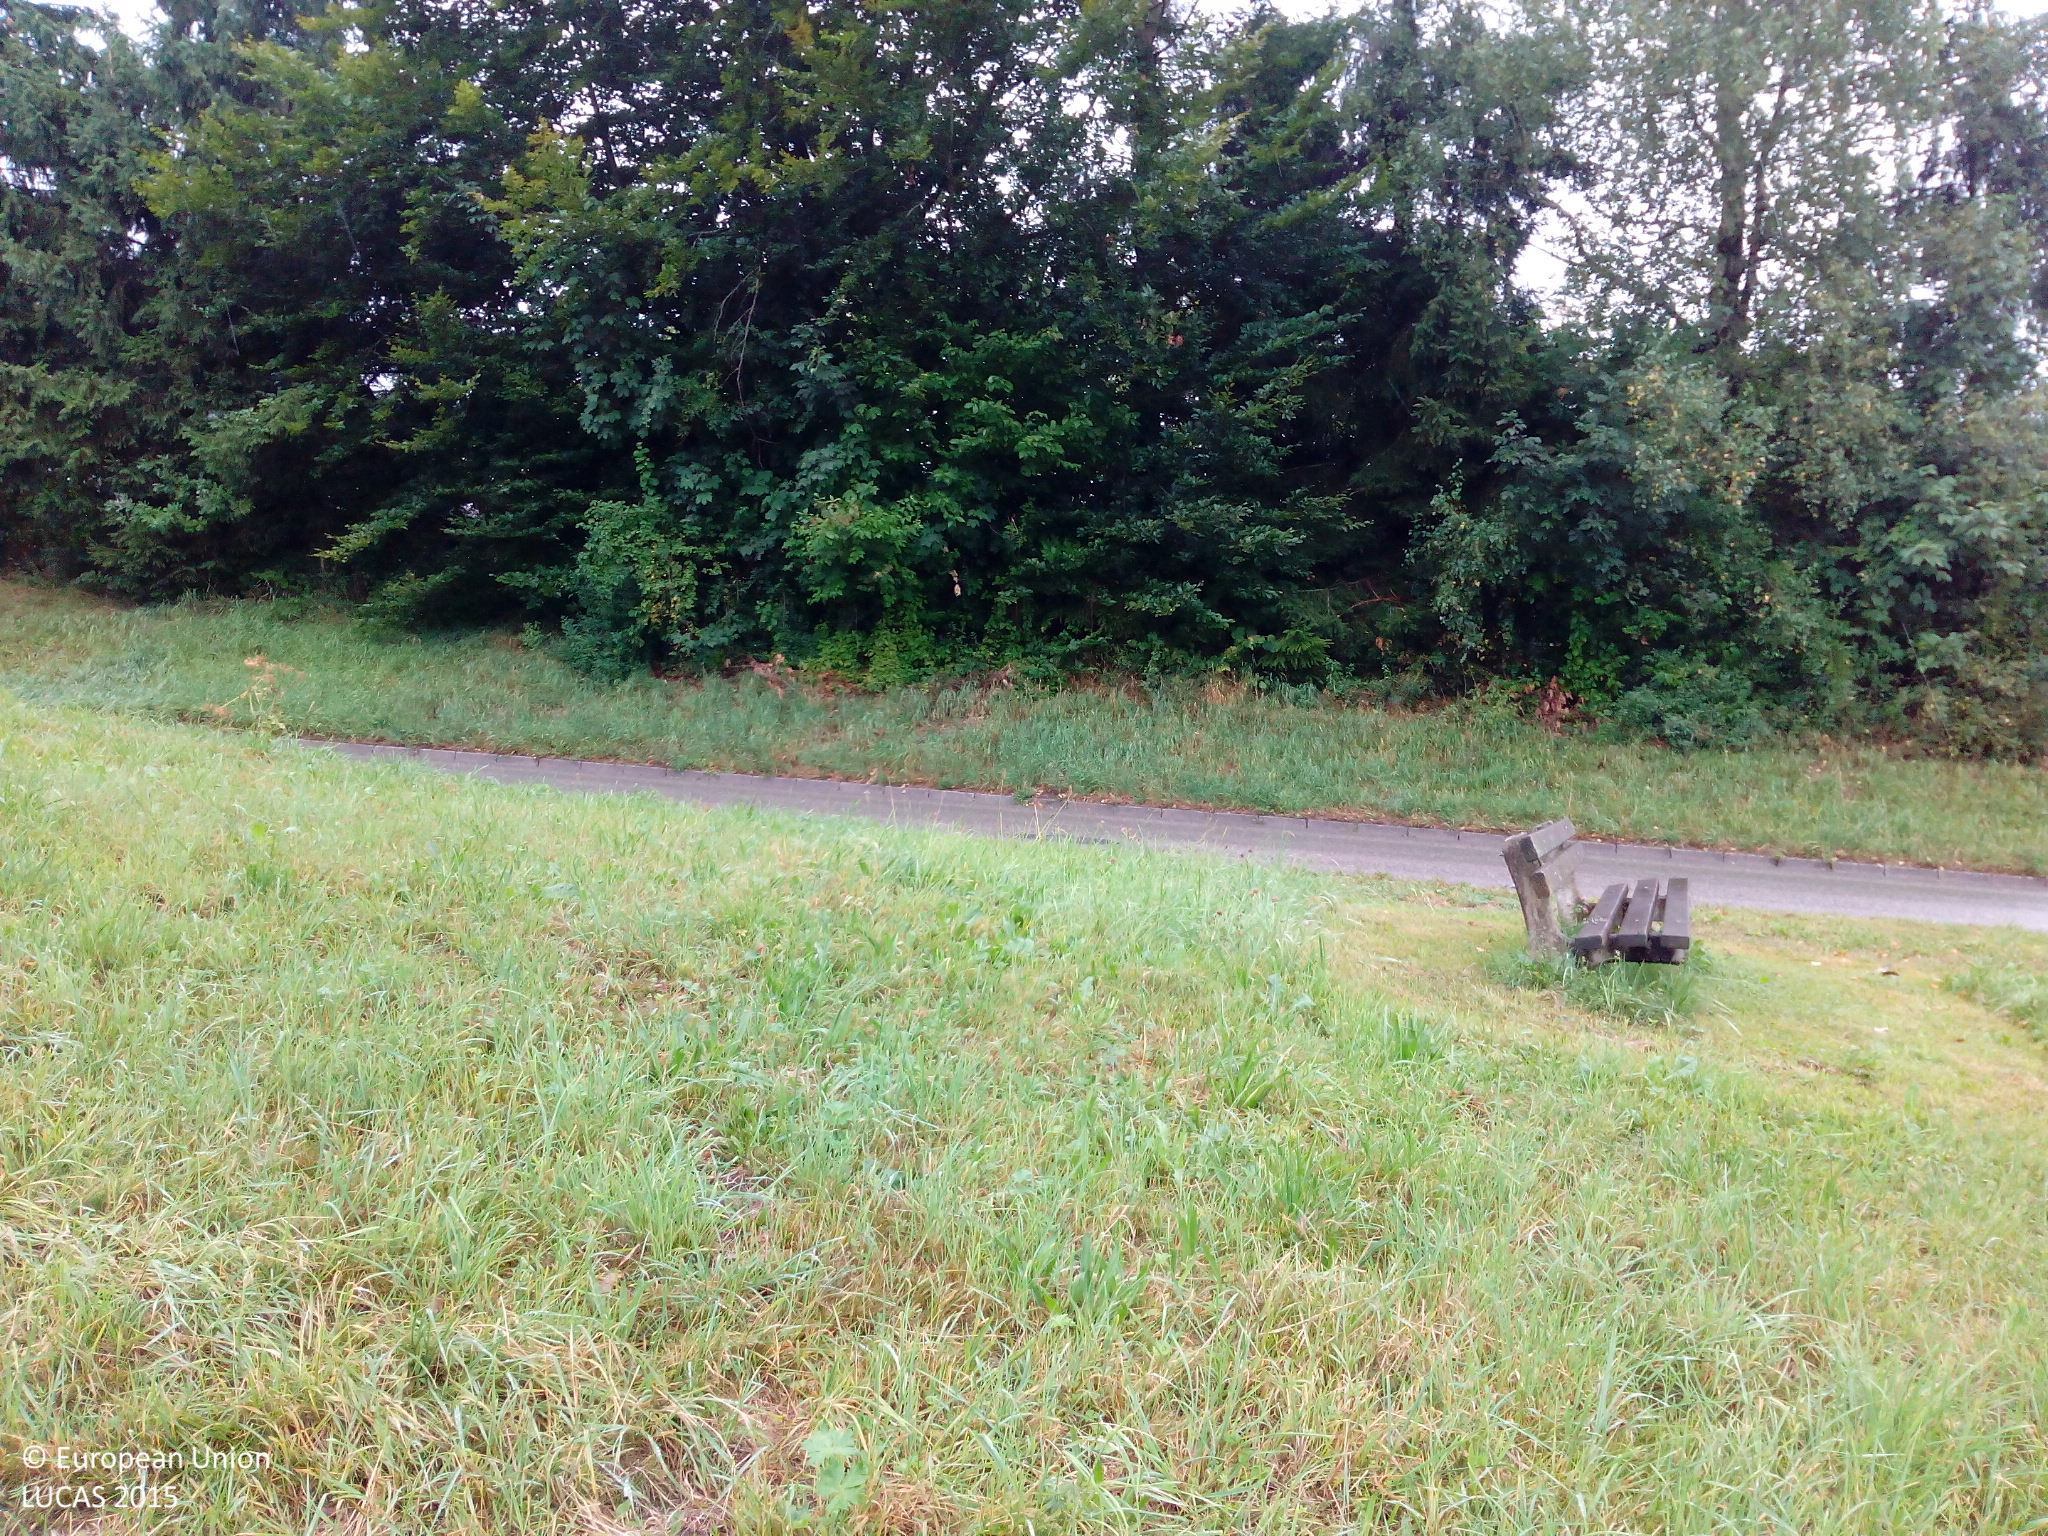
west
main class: Grassland
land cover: Grassland with sparse tree/shrub cover
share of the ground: > 75 %
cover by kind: herbaceous plants 95 %, broadleaved forest trees 5 %
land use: Residential
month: August
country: DE
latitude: 47.8260
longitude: 12.8706
